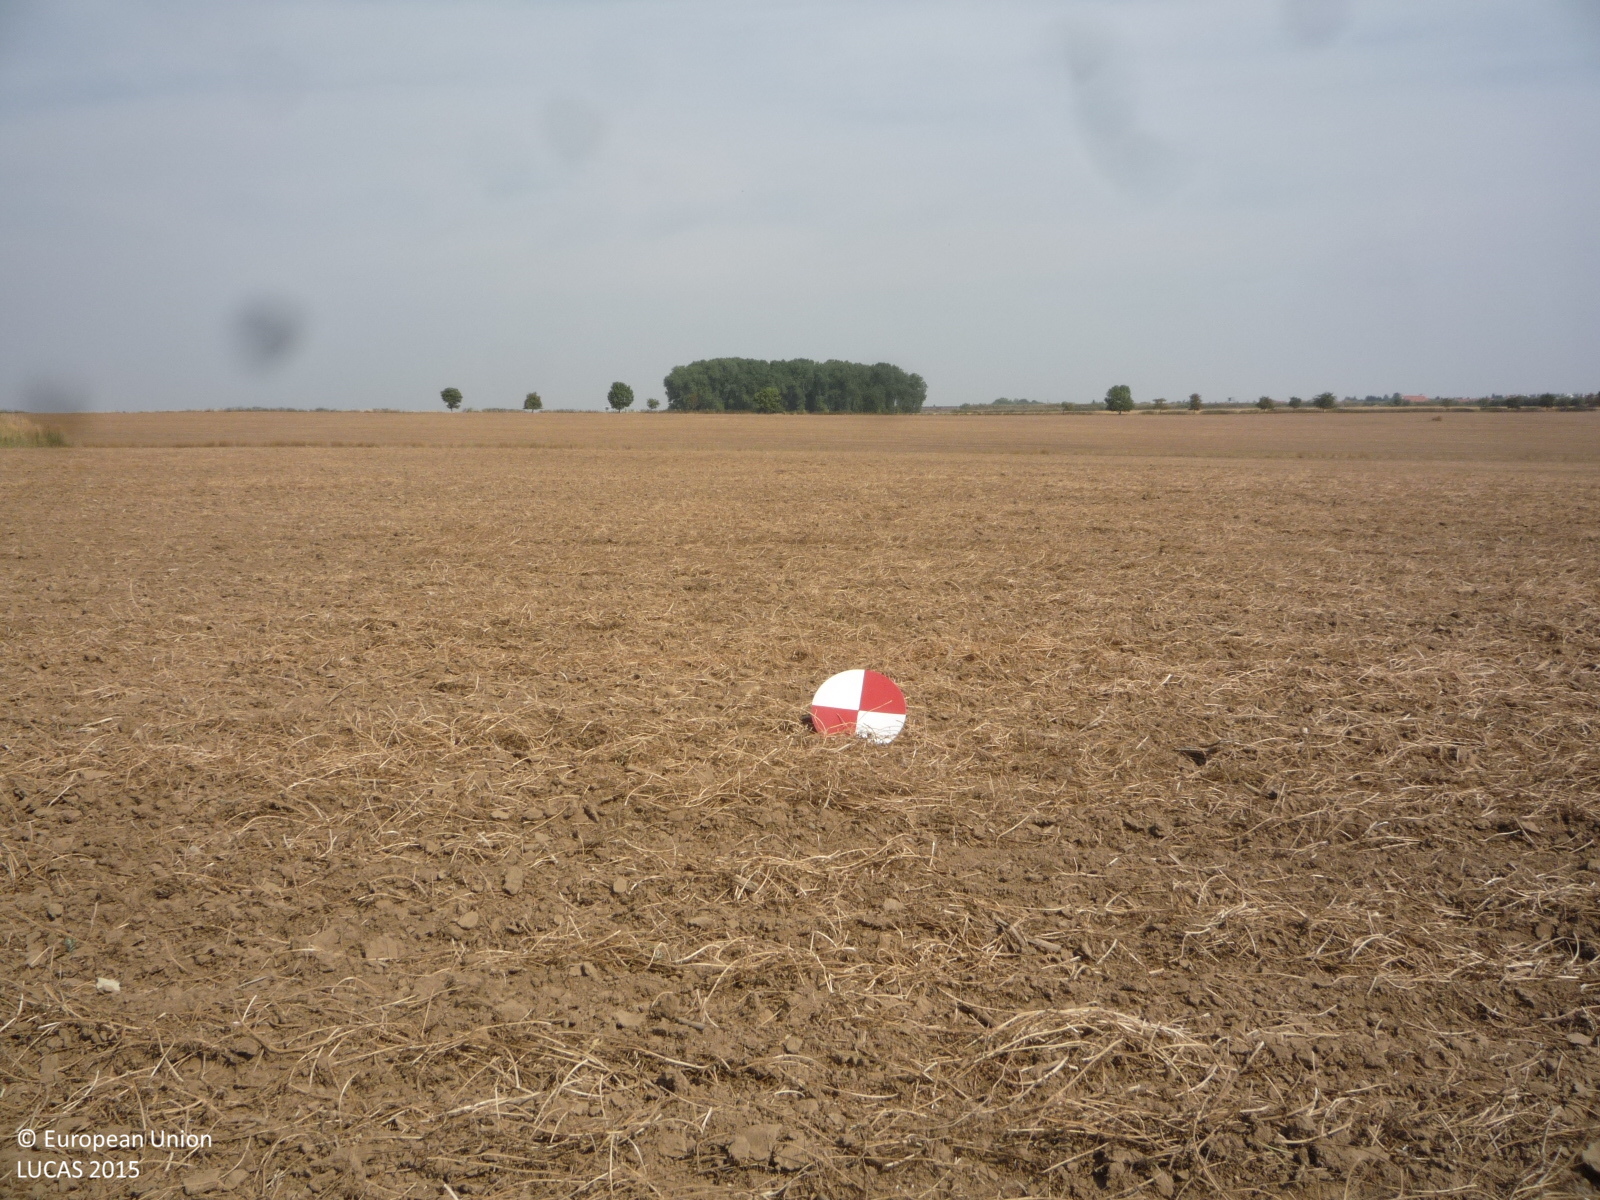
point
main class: Cropland
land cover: Dry pulses
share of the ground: < 10 %
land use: Agriculture (excluding fallow land and kitchen gardens)
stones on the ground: < 10 %
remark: Harvested field
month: August
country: CZ
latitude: 49.9512
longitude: 14.5033
